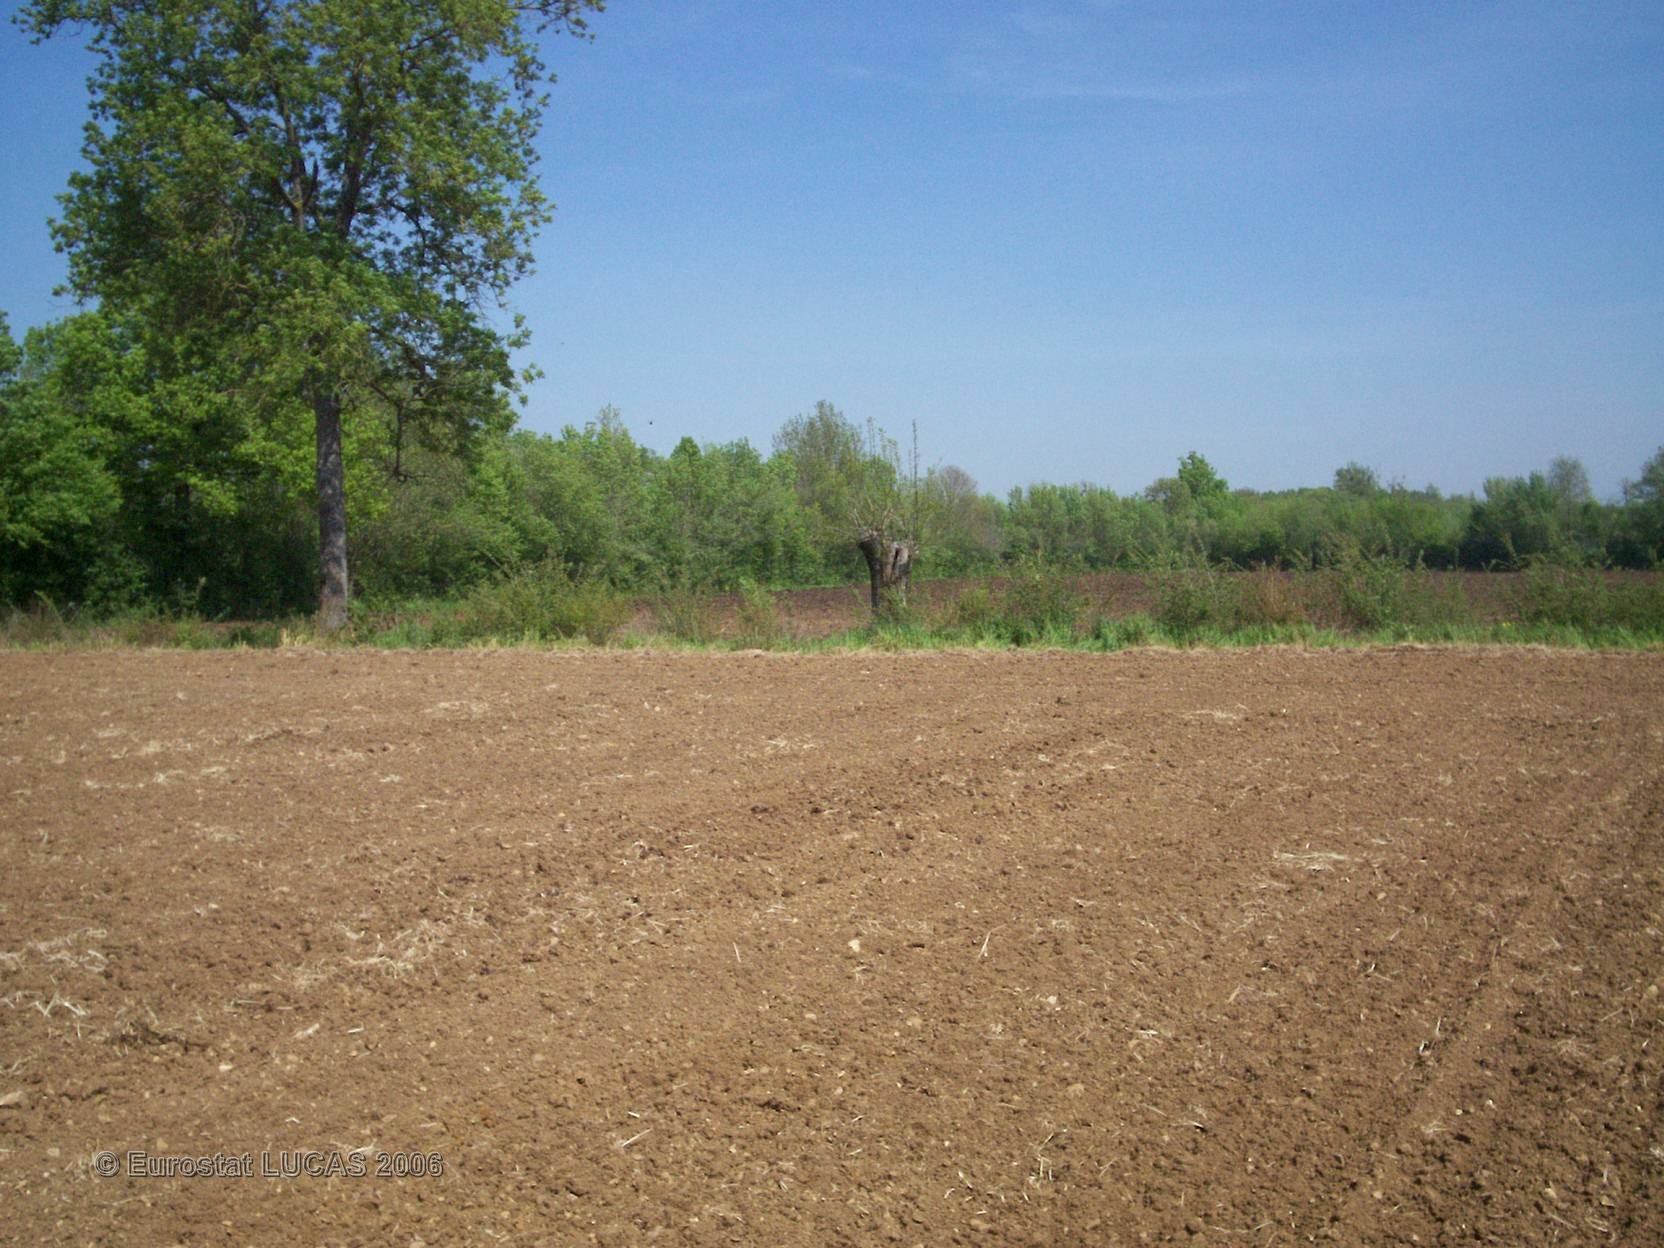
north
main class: Cropland
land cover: Sunflower
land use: Agriculture (excluding fallow land and kitchen gardens)
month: May
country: FR
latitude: 46.1669
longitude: -0.2411
